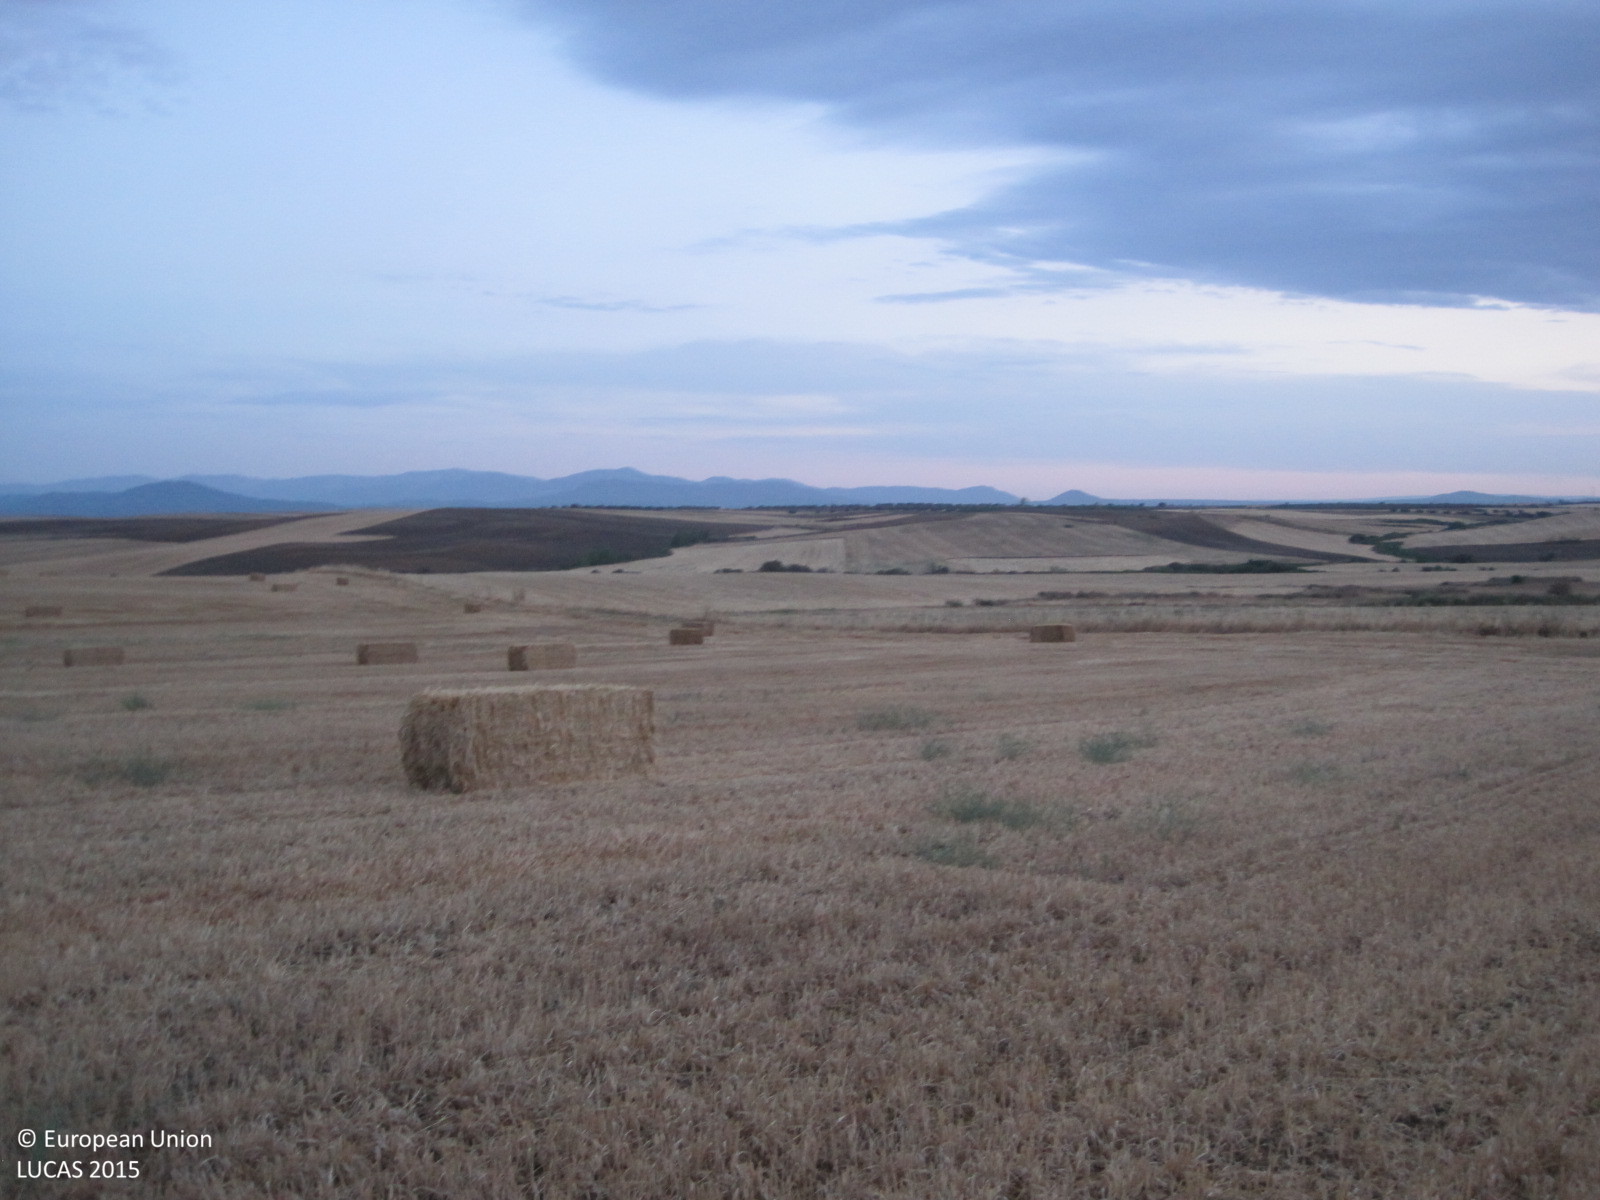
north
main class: Cropland
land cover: Oats
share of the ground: < 10 %
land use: Agriculture (excluding fallow land and kitchen gardens)
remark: Harvested field
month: July
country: ES
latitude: 40.0707
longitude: -4.3349
